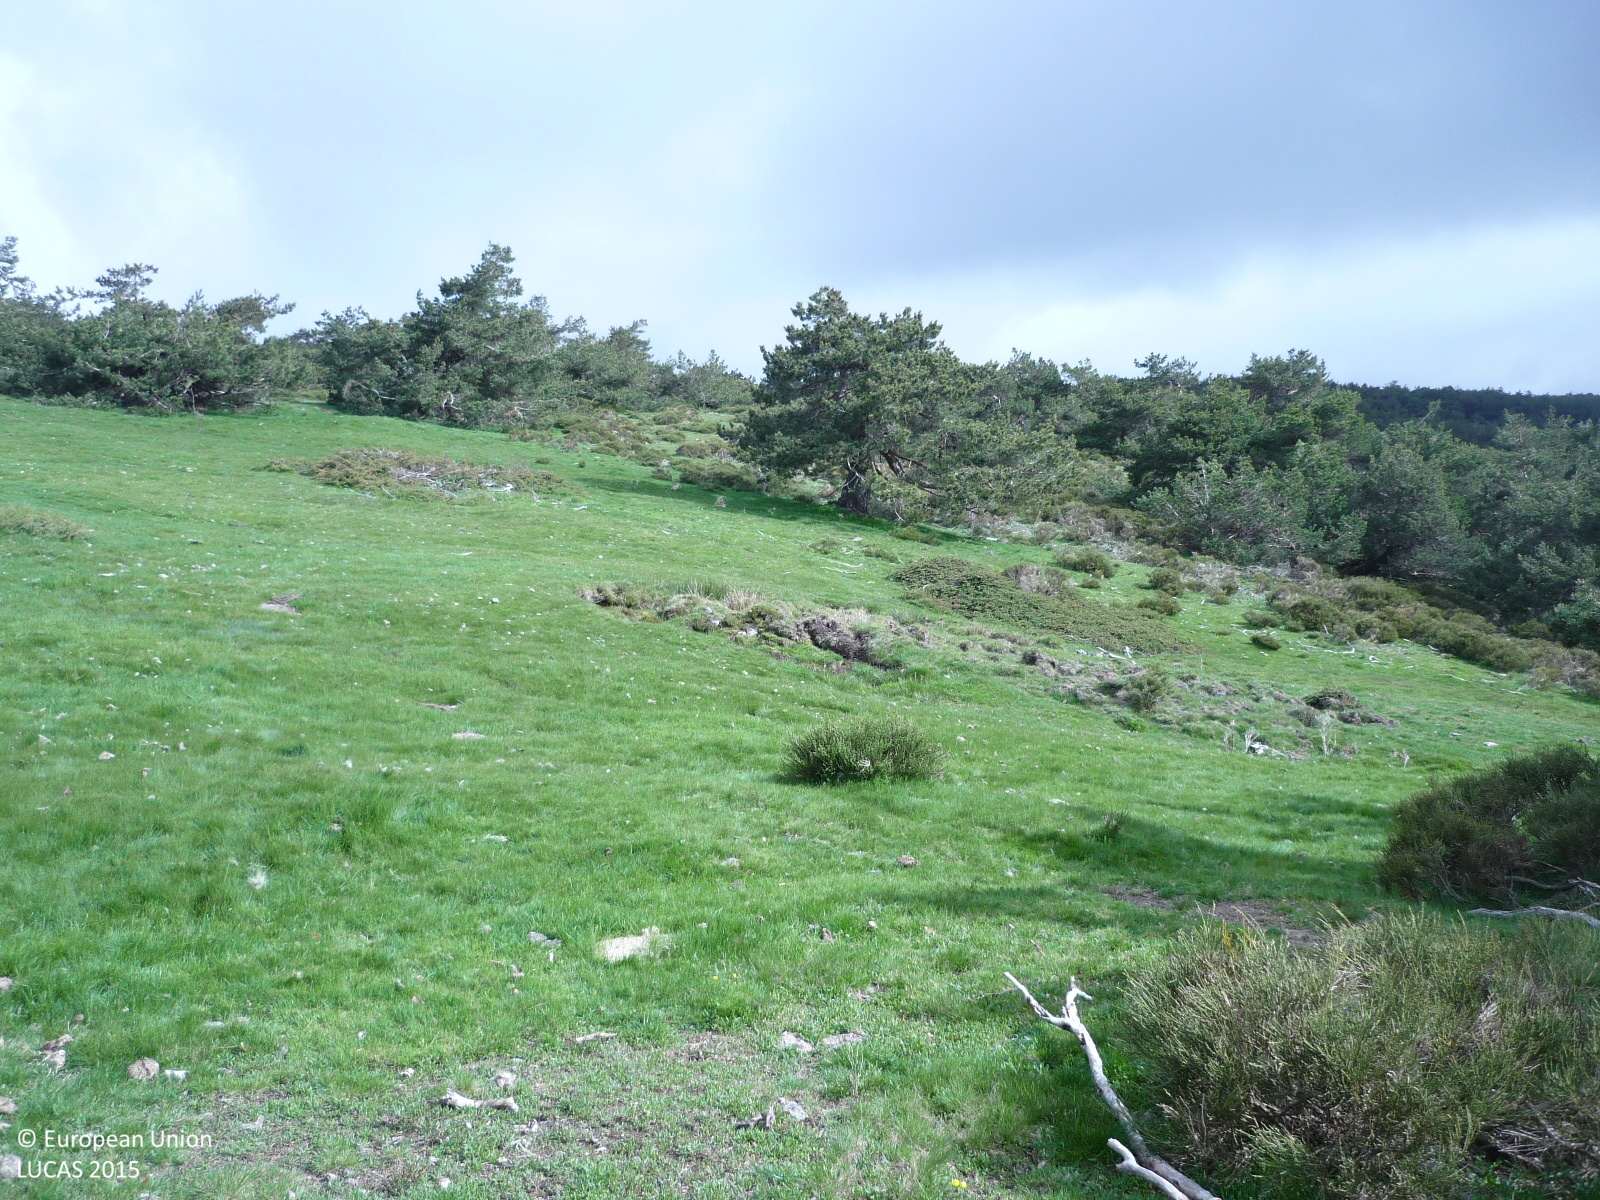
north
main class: Woodland
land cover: Pine dominated coniferous woodland
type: coniferous forest of the mediterranean region
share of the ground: 50 - 75 %
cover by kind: coniferous forest trees 60 %, herbaceous plants 30 %, shrubs 10 %
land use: Forestry
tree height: > 5 m
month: May
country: ES
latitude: 41.0780
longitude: -3.6980
